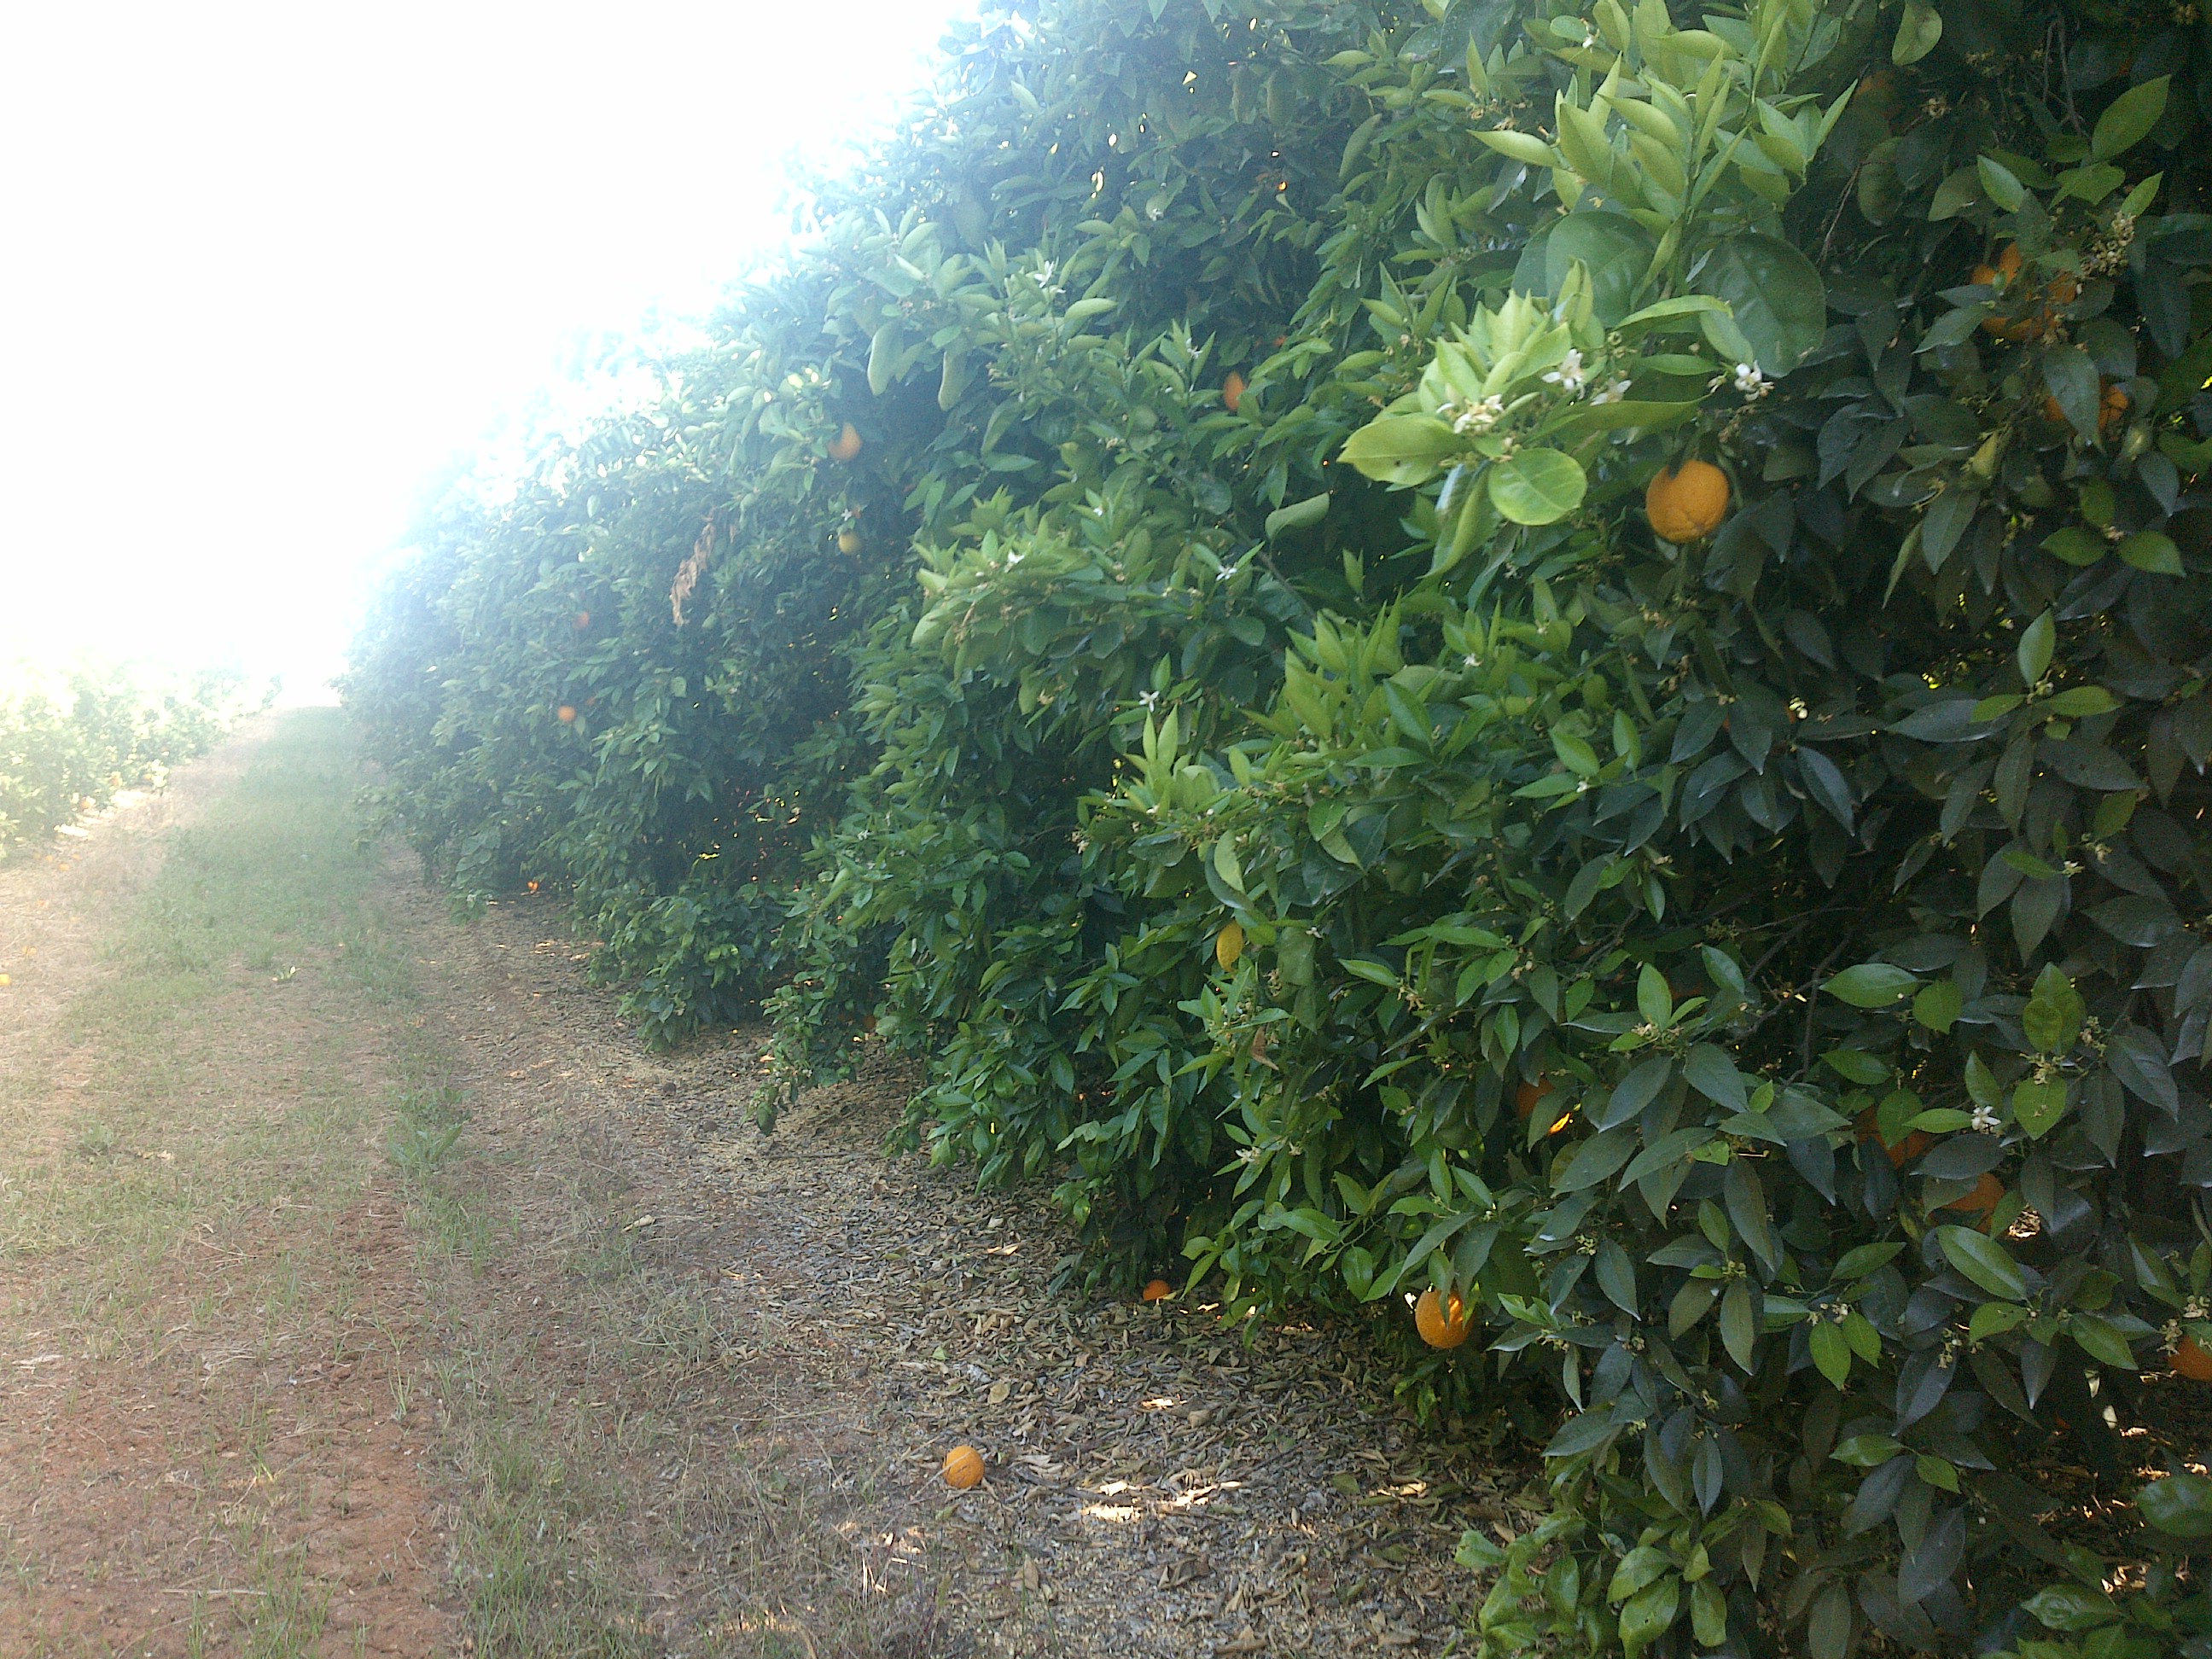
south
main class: Cropland
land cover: Oranges
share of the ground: > 75 %
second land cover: Spontaneously vegetated surfaces
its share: 25 - 50 %
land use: Agriculture (excluding fallow land and kitchen gardens)
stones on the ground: < 10 %
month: May
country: ES
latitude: 37.7880
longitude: -5.2007
